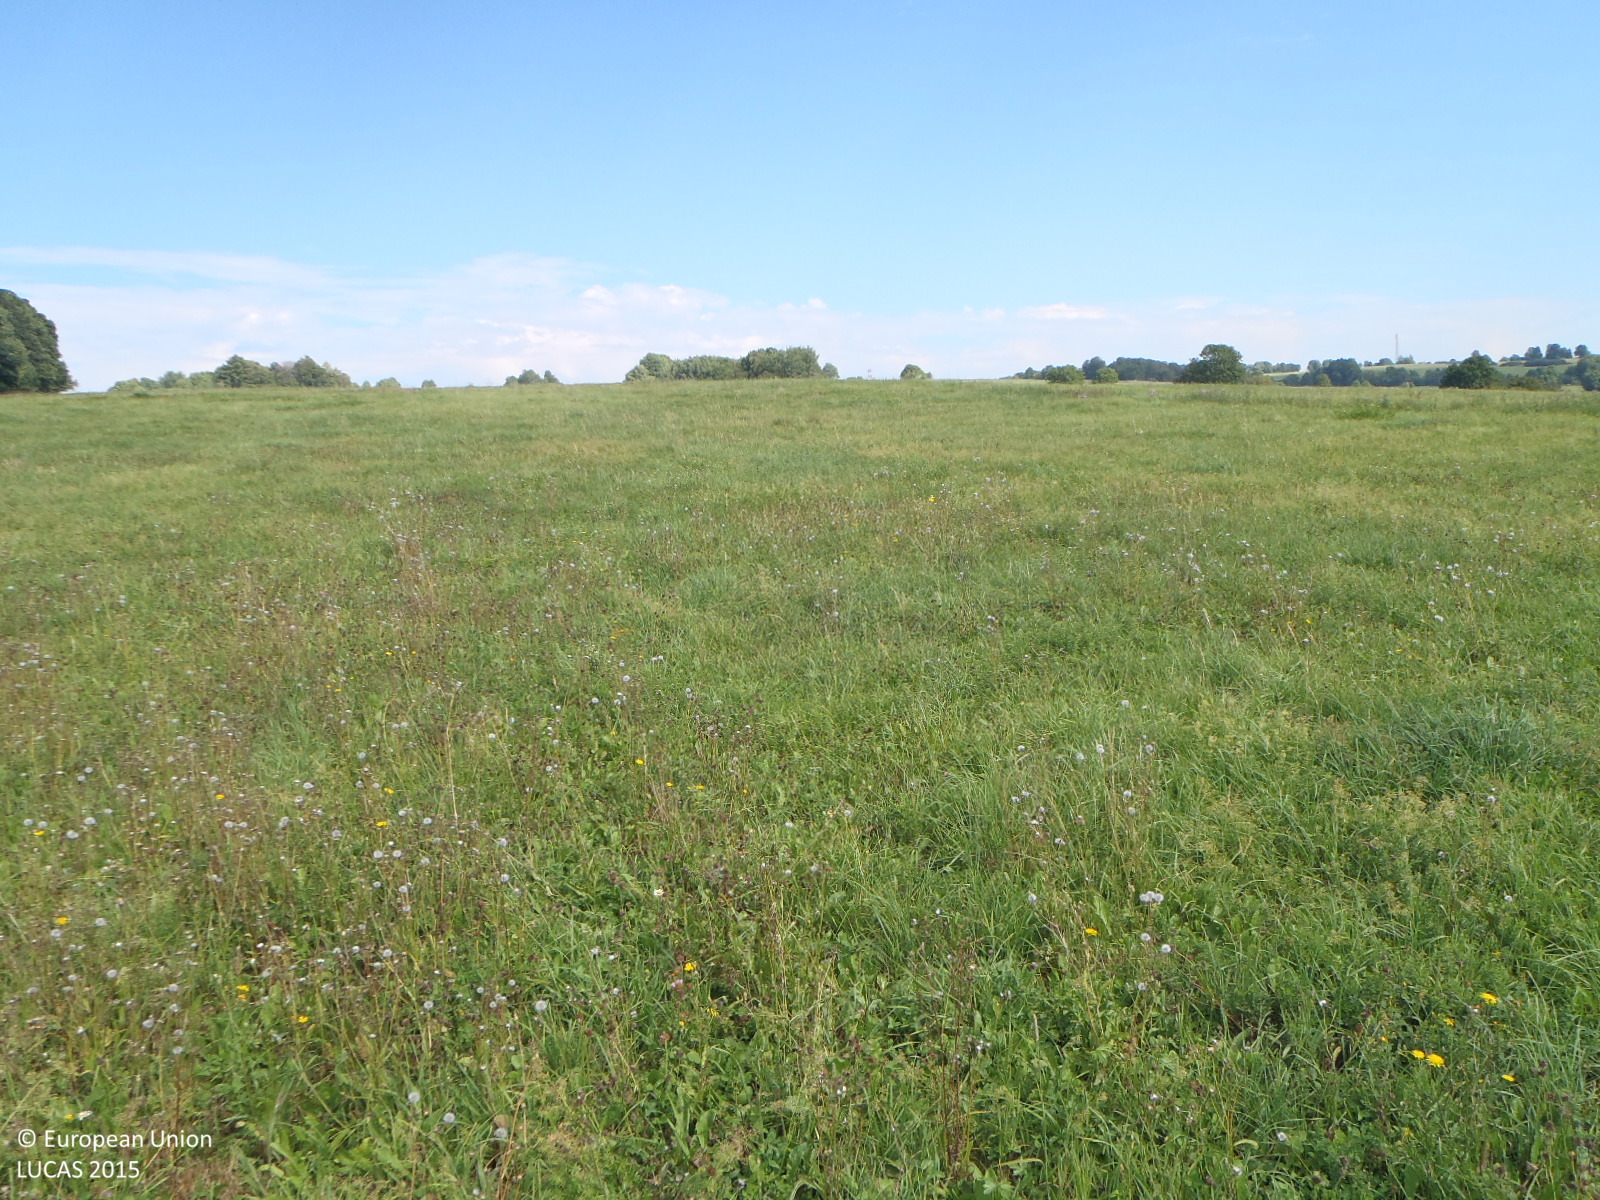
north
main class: Grassland
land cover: Grassland without tree/shrub cover
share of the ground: > 75 %
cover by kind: herbaceous plants 100 %
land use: Agriculture (excluding fallow land and kitchen gardens)
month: August
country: CZ
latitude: 50.8853
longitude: 14.5649
